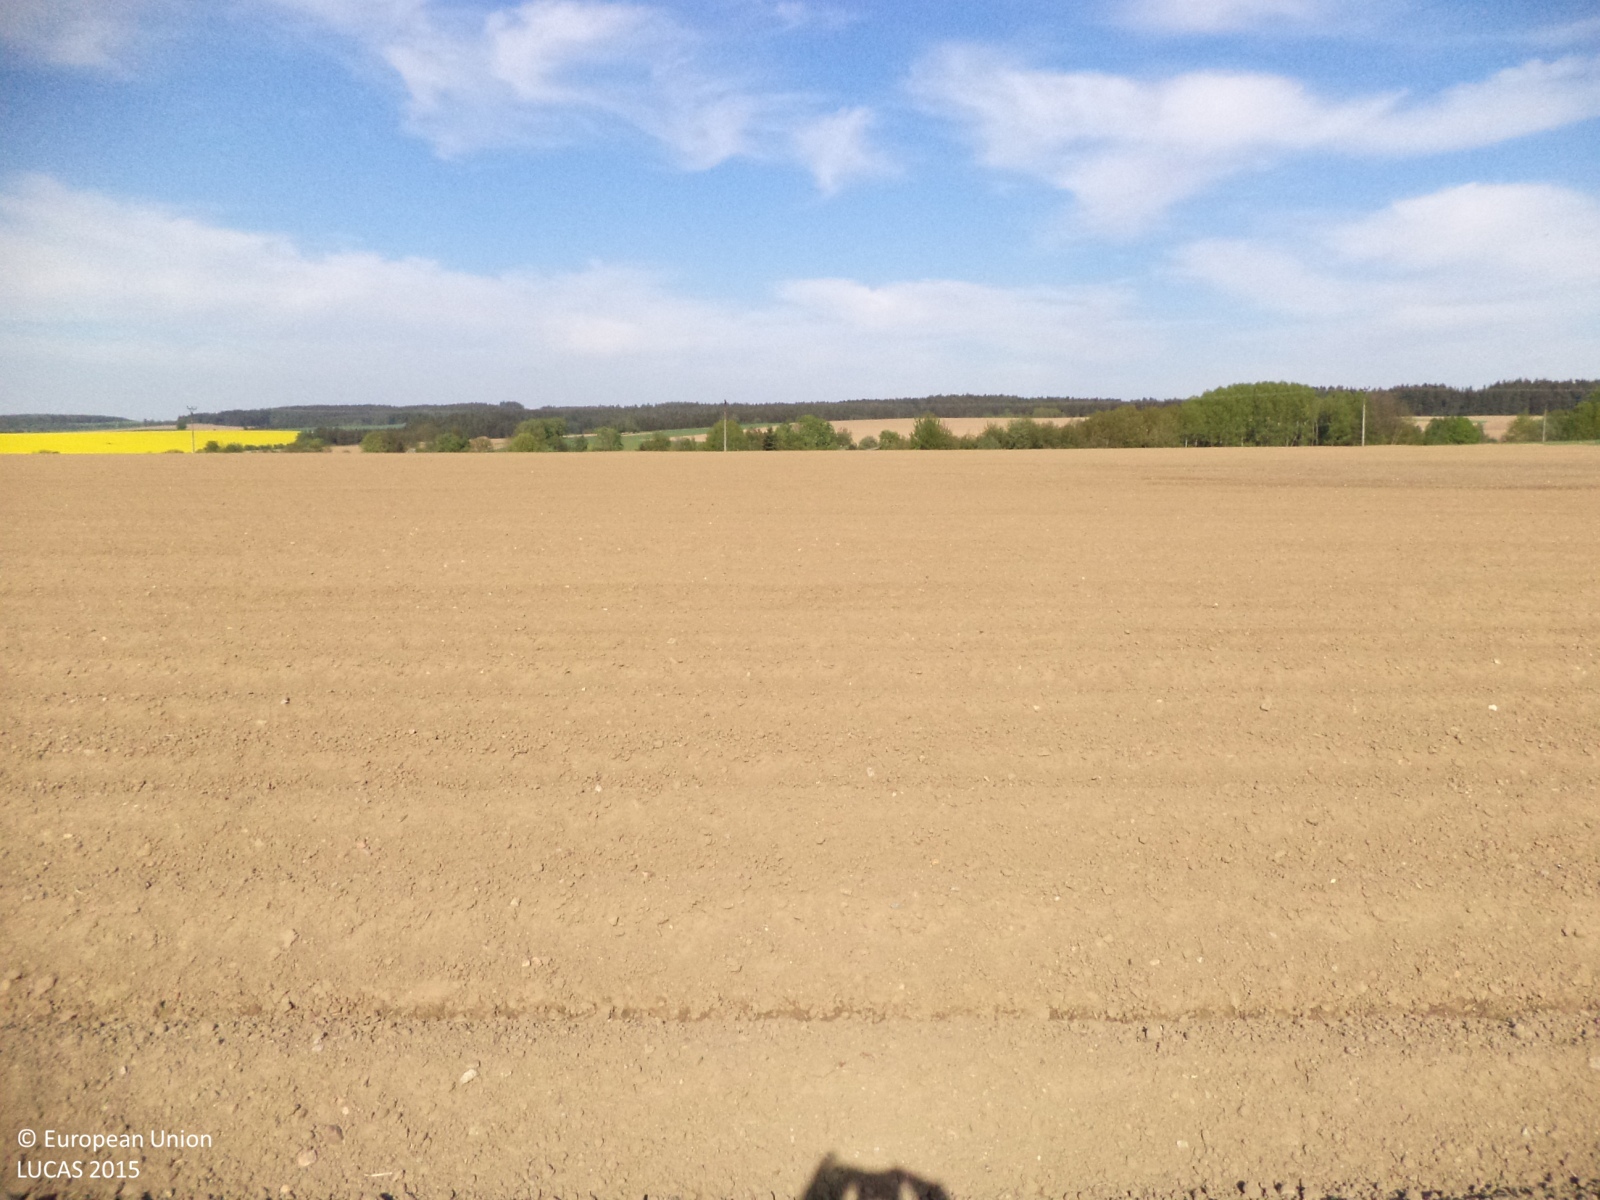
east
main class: Cropland
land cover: Potatoes
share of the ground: < 10 %
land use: Agriculture (excluding fallow land and kitchen gardens)
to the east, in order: Potatoes; Electric lines; Maize; Oats; Grassland without tree/shrub cover; Tracks; Grass margins; Barley
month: May
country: CZ
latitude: 49.4578
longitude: 15.0934
